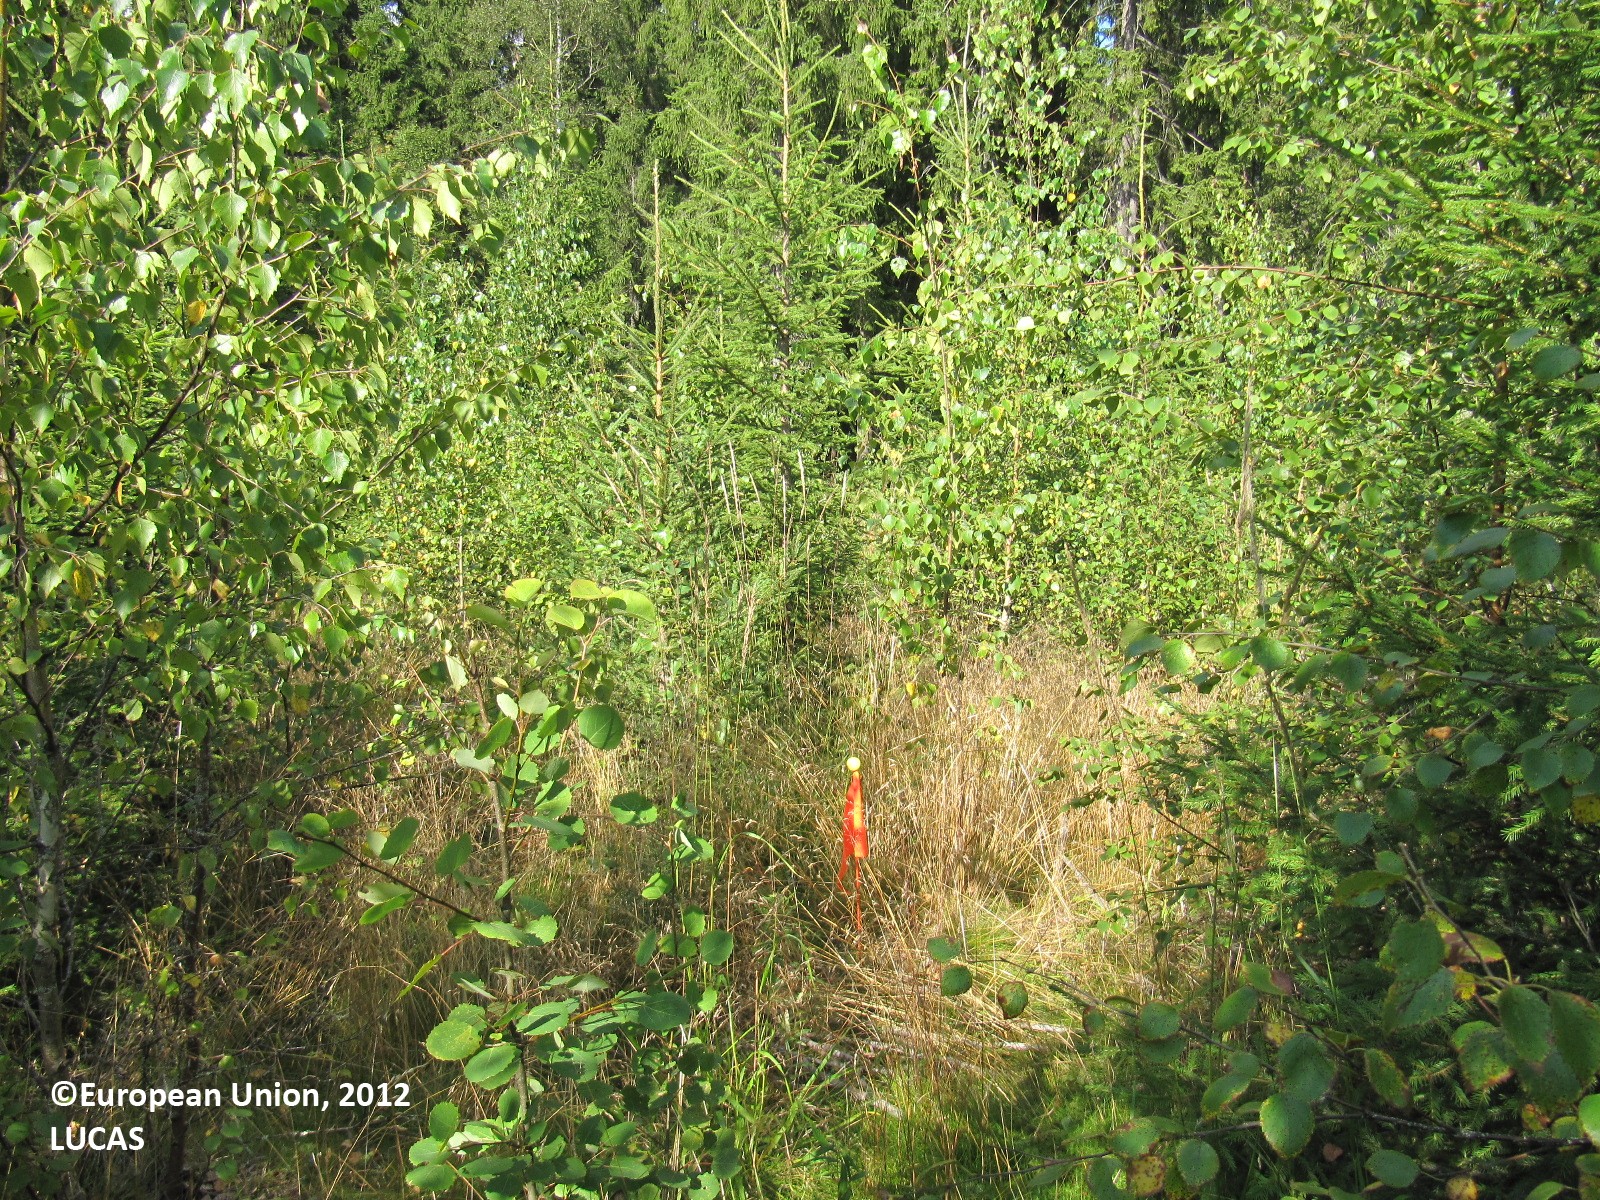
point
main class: Woodland
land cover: Other mixed woodland
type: boreal forest
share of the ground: > 75 %
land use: Forestry
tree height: < 5 m
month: August
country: FI
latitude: 60.6267
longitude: 24.6011
